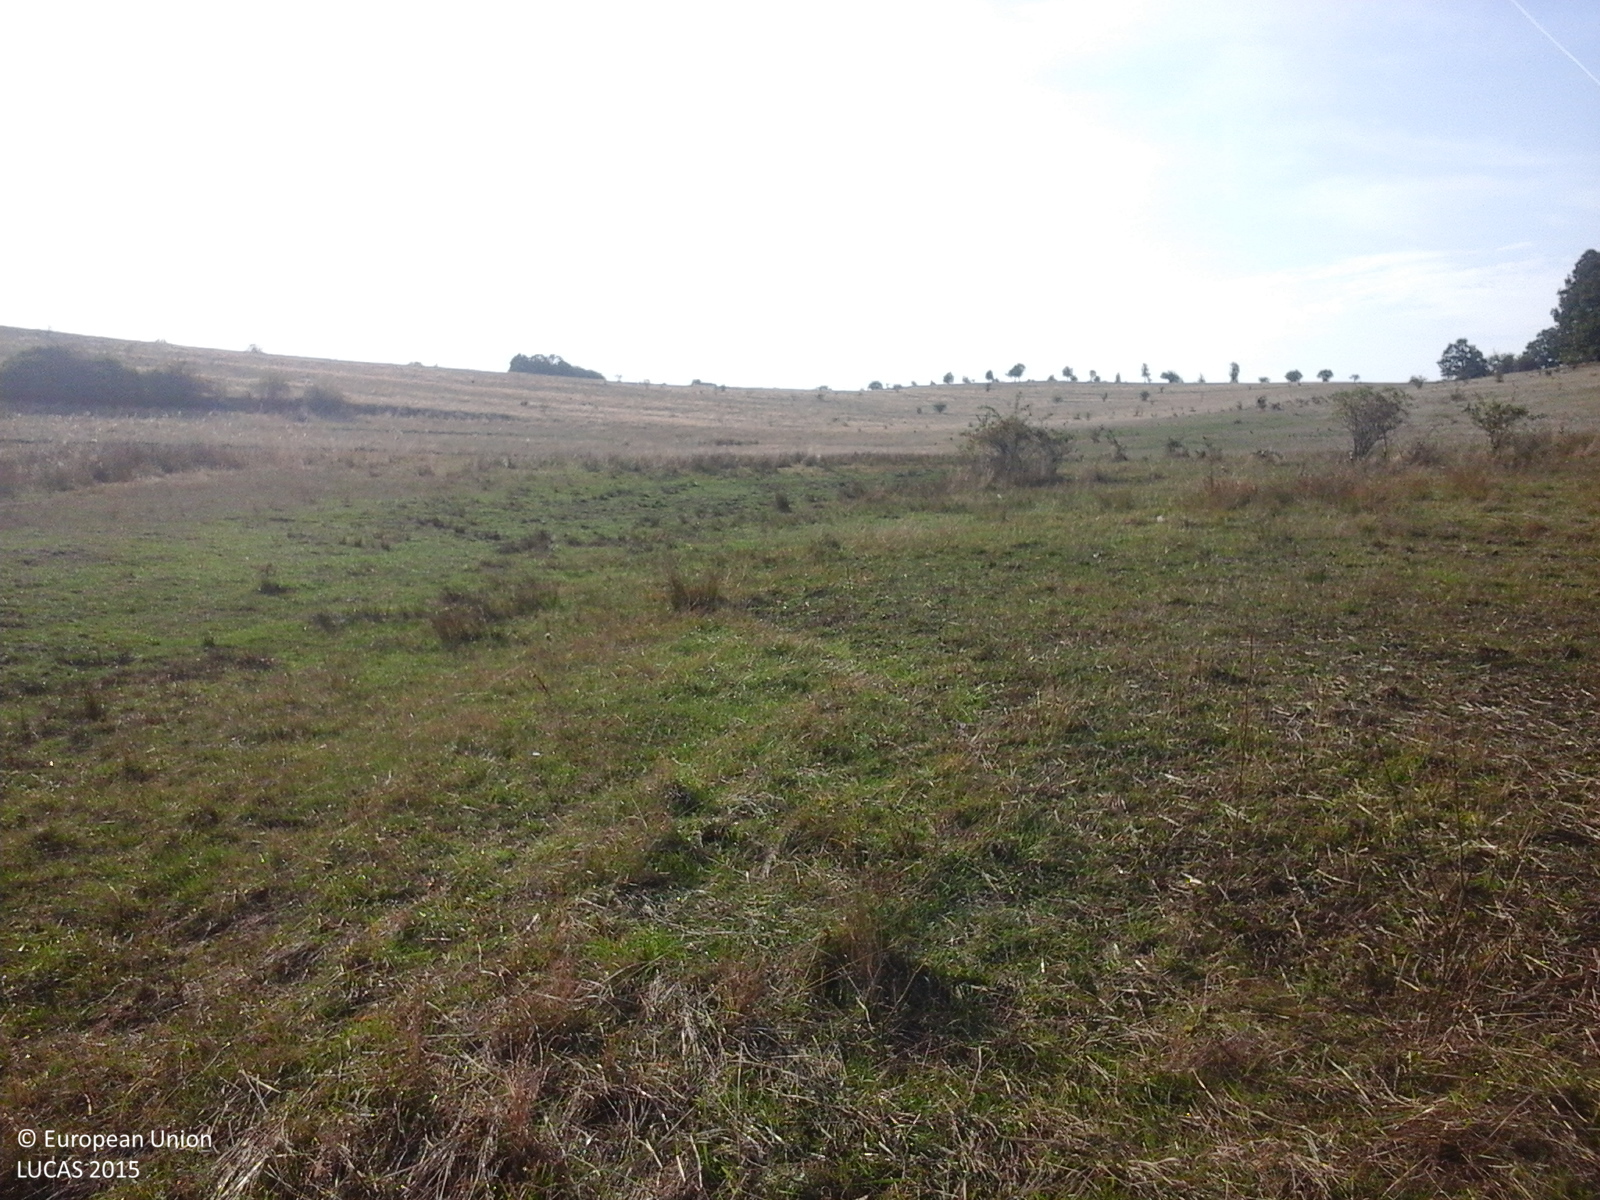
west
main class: Grassland
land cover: Grassland without tree/shrub cover
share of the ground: > 75 %
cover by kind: herbaceous plants 100 %
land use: Agriculture (excluding fallow land and kitchen gardens)
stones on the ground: < 10 %
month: September
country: RO
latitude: 47.1113
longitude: 23.5272
